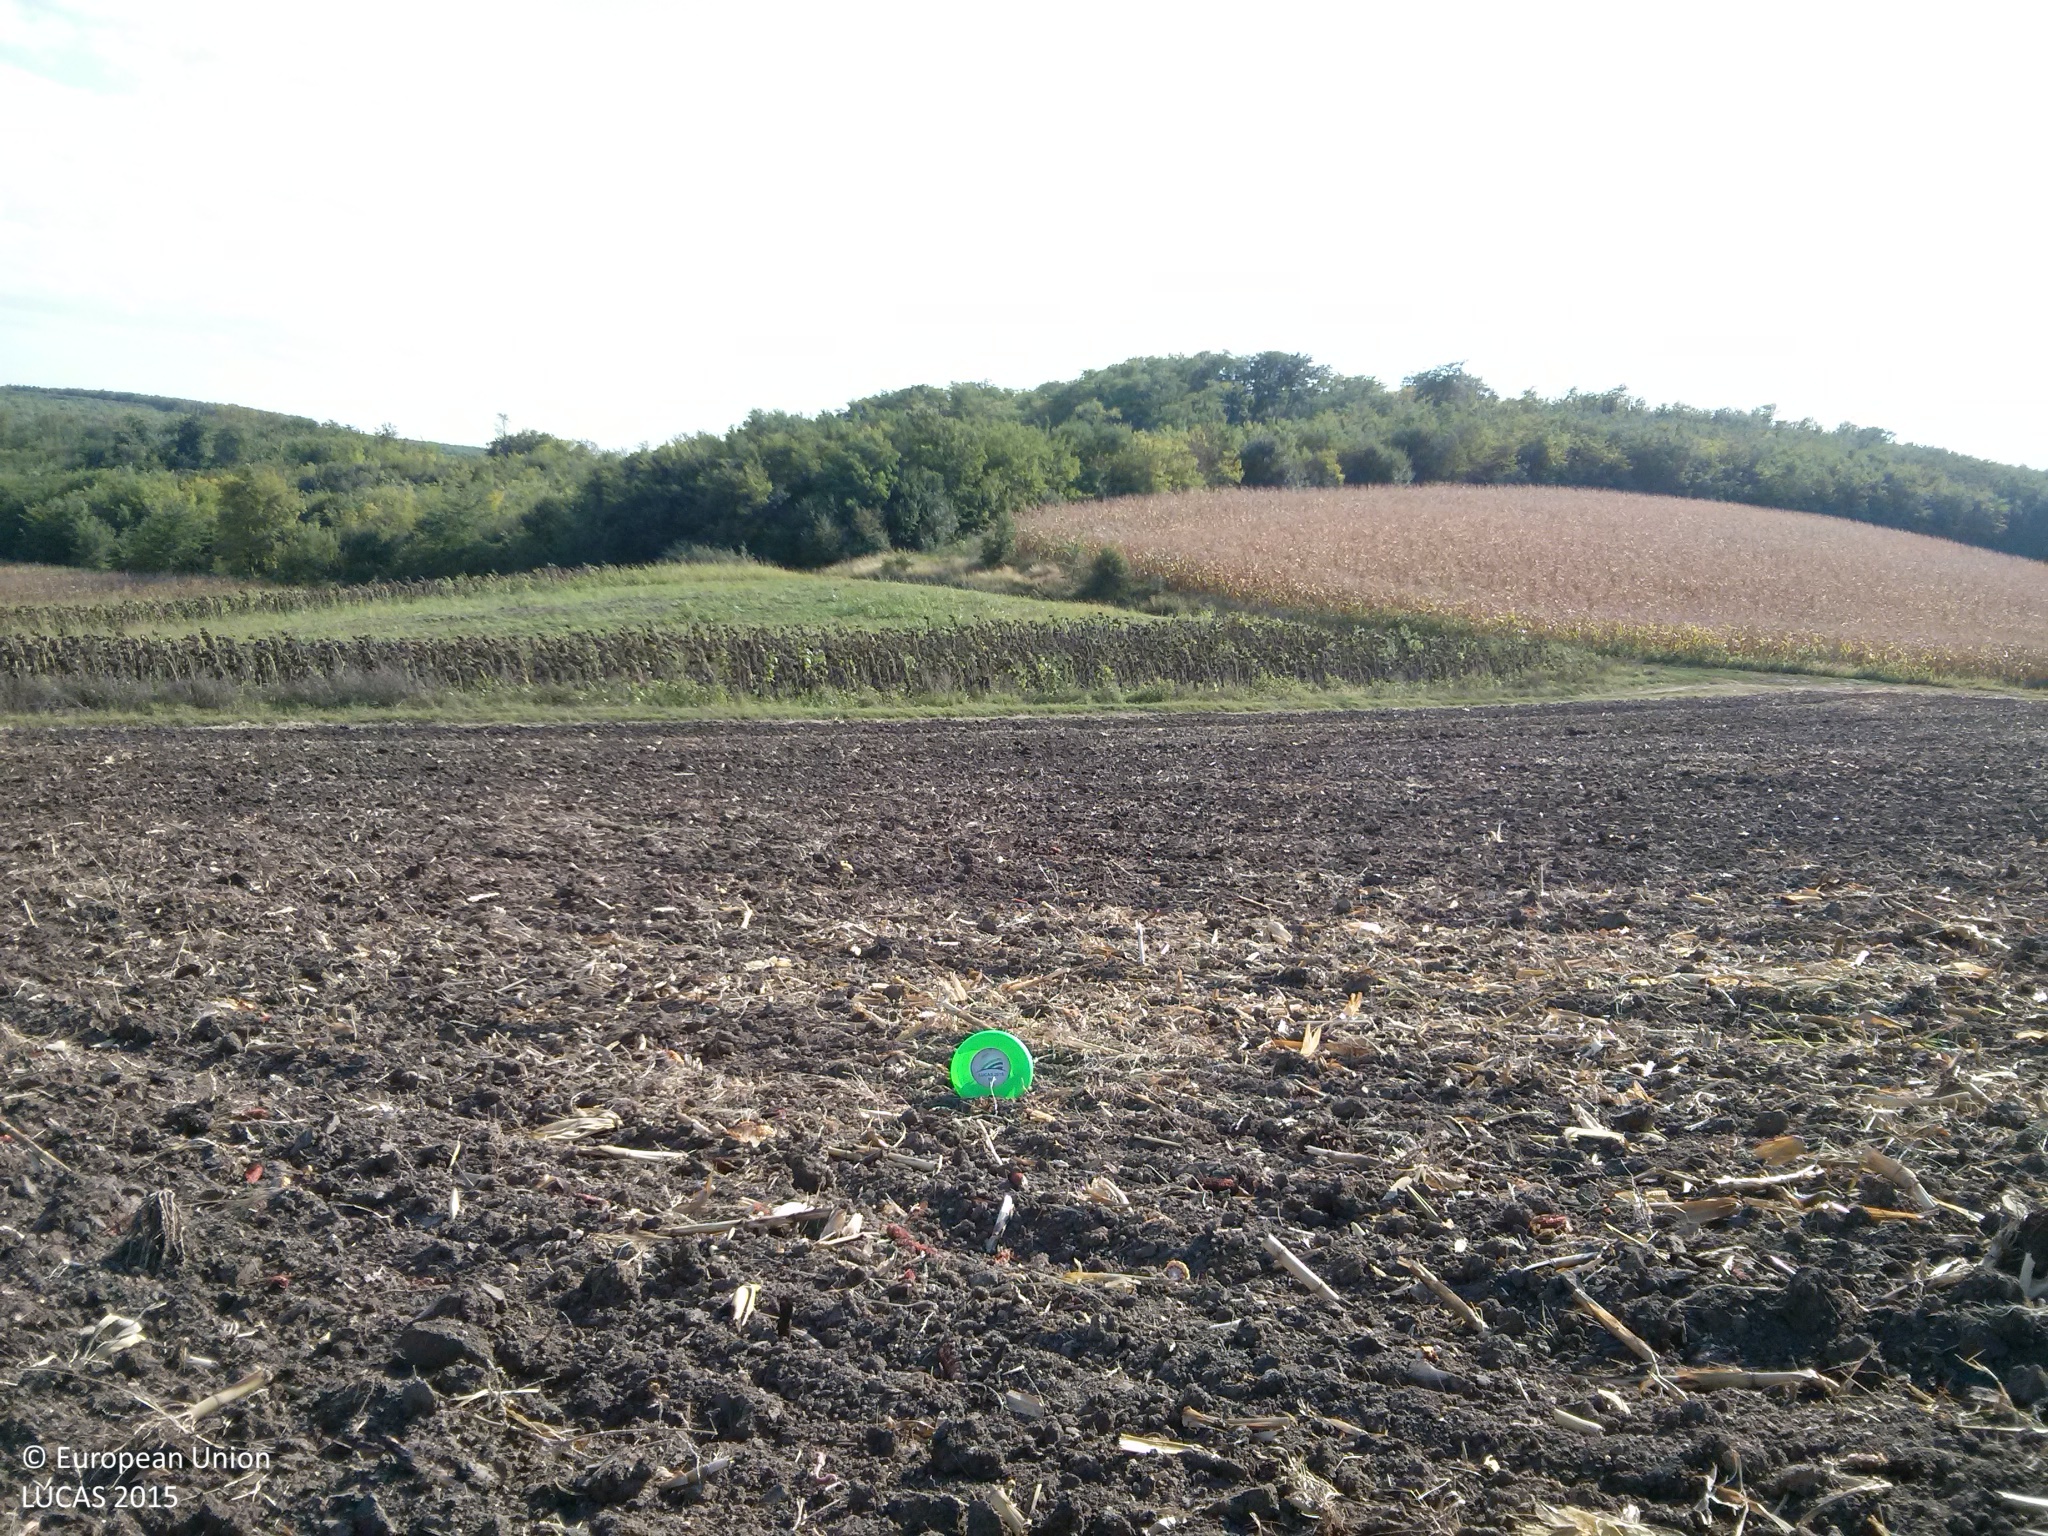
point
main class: Cropland
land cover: Maize
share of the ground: < 10 %
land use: Agriculture (excluding fallow land and kitchen gardens)
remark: Harvested field
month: September
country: BG
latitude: 43.9038
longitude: 26.4815
